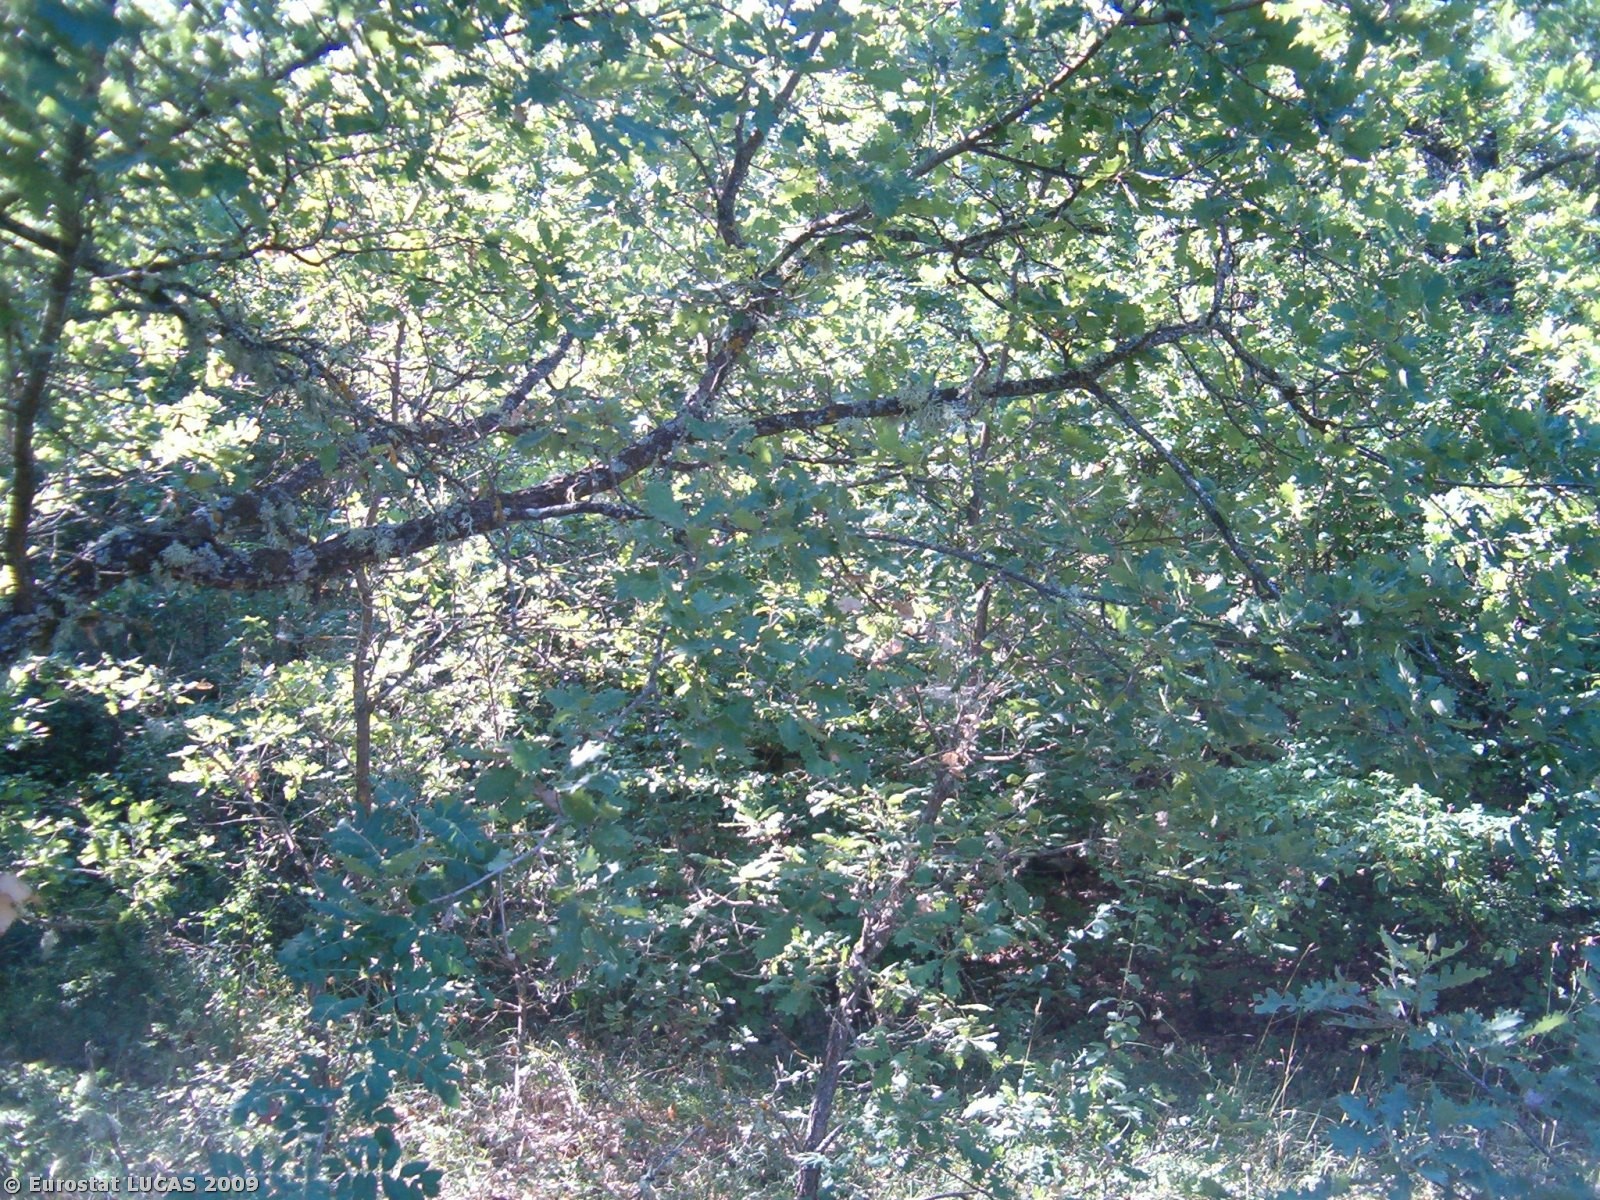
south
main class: Woodland
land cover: Broadleaved woodland
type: thermophilous deciduous forest
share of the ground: > 75 %
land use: Forestry
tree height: > 5 m
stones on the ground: 10 - 25 %
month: August
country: IT
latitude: 42.3463
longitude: 13.3274
